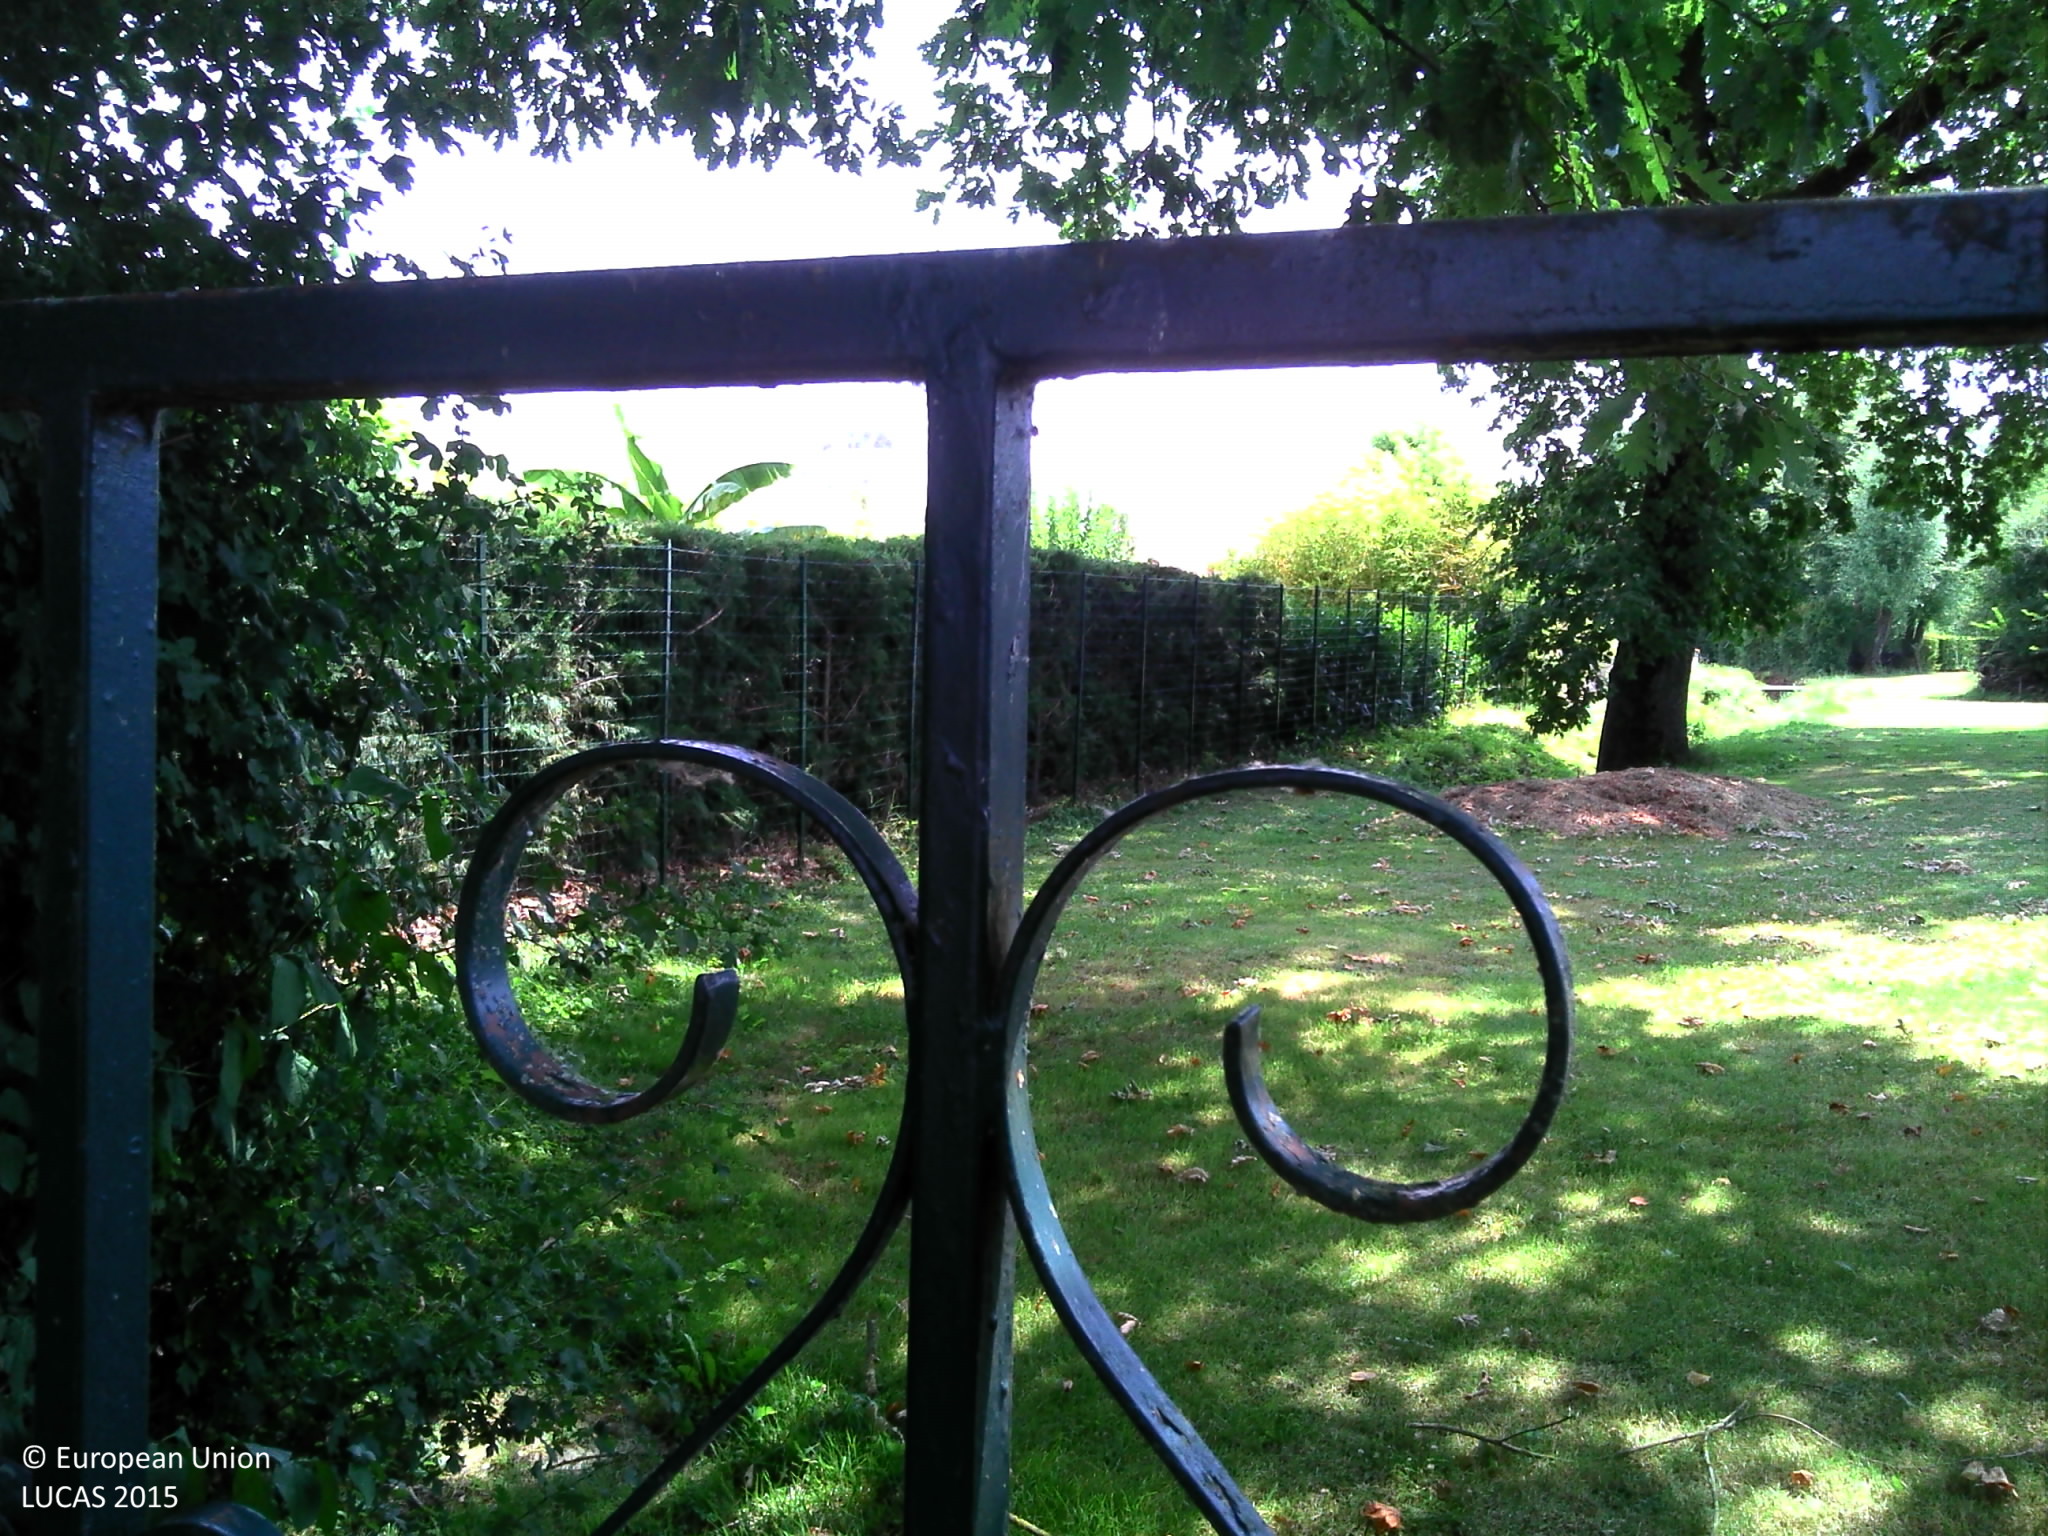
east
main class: Grassland
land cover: Grassland with sparse tree/shrub cover
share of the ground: > 75 %
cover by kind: herbaceous plants 95 %, broadleaved forest trees 5 %
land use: Residential
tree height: > 5 m
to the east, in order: Grassland with sparse tree/shrub cover; Pine dominated mixed woodland; Artificial constructions in urban areas
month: July
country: FR
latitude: 43.6816
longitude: 1.5800
